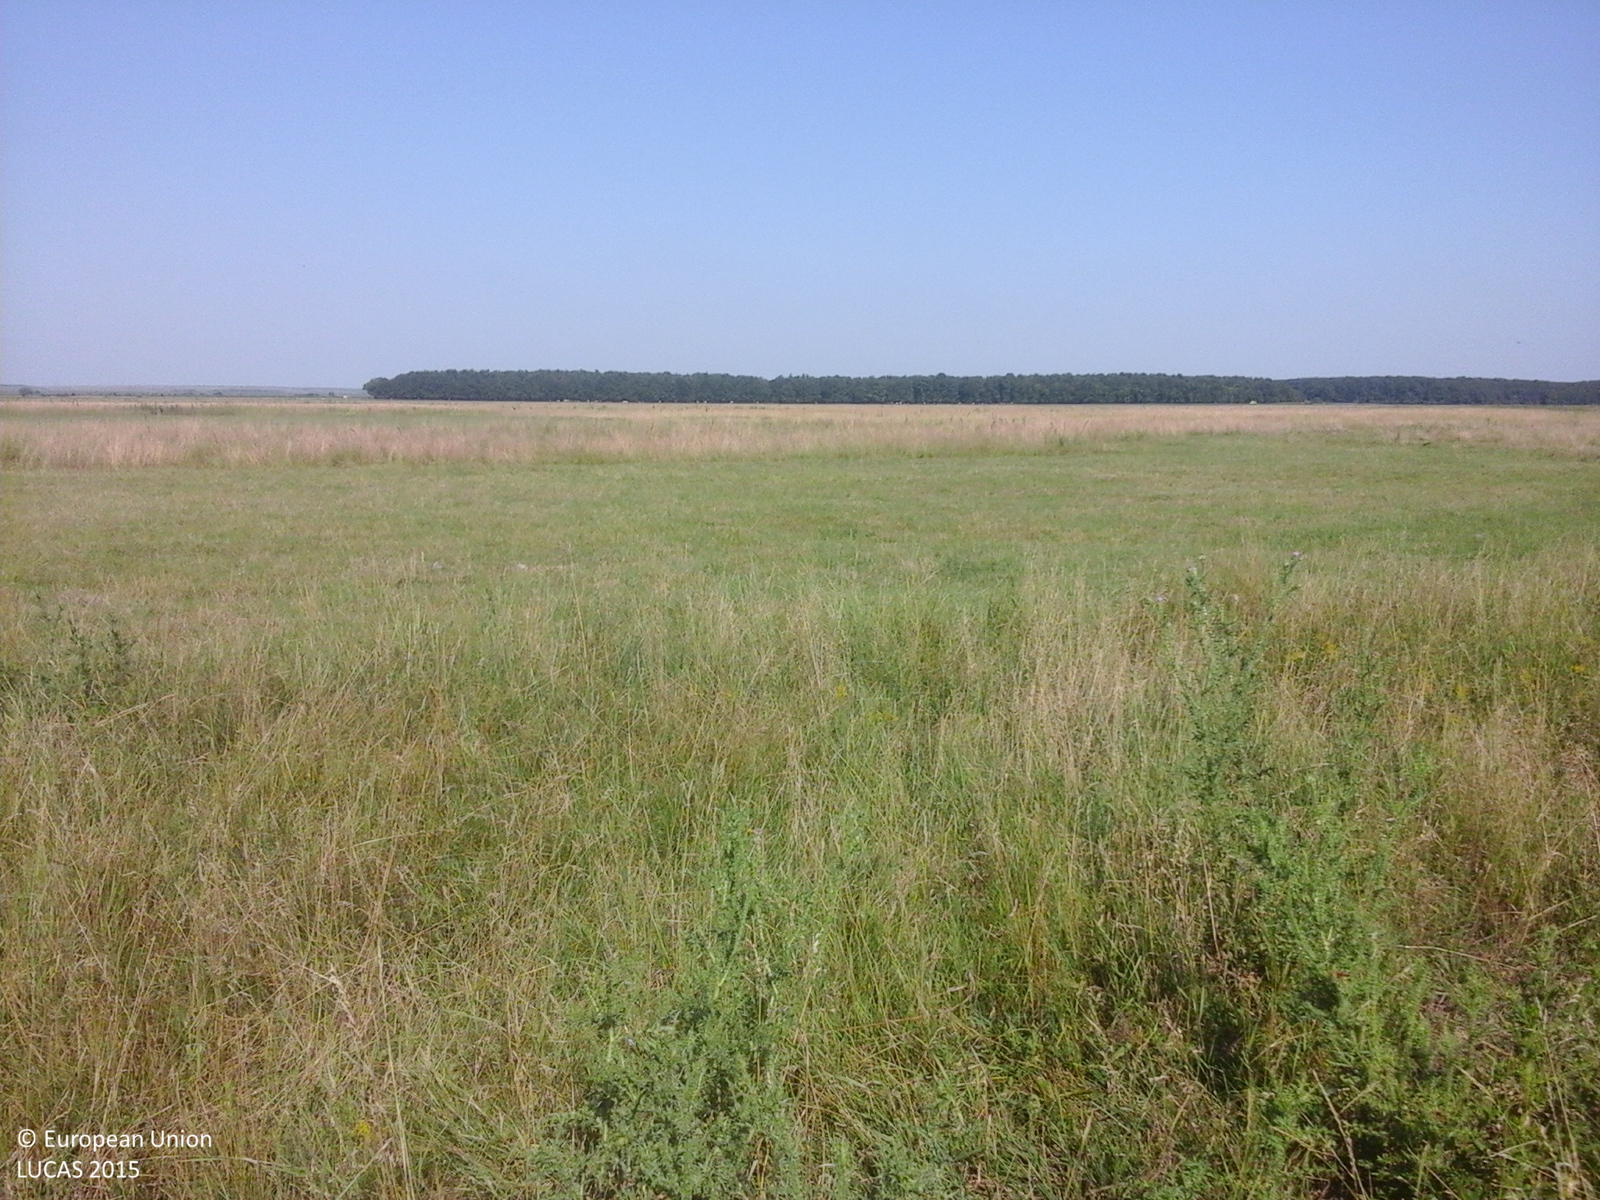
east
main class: Grassland
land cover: Grassland without tree/shrub cover
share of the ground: > 75 %
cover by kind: herbaceous plants 100 %
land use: Agriculture (excluding fallow land and kitchen gardens)
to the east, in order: Grassland without tree/shrub cover
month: July
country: RO
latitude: 44.2642
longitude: 24.3336
